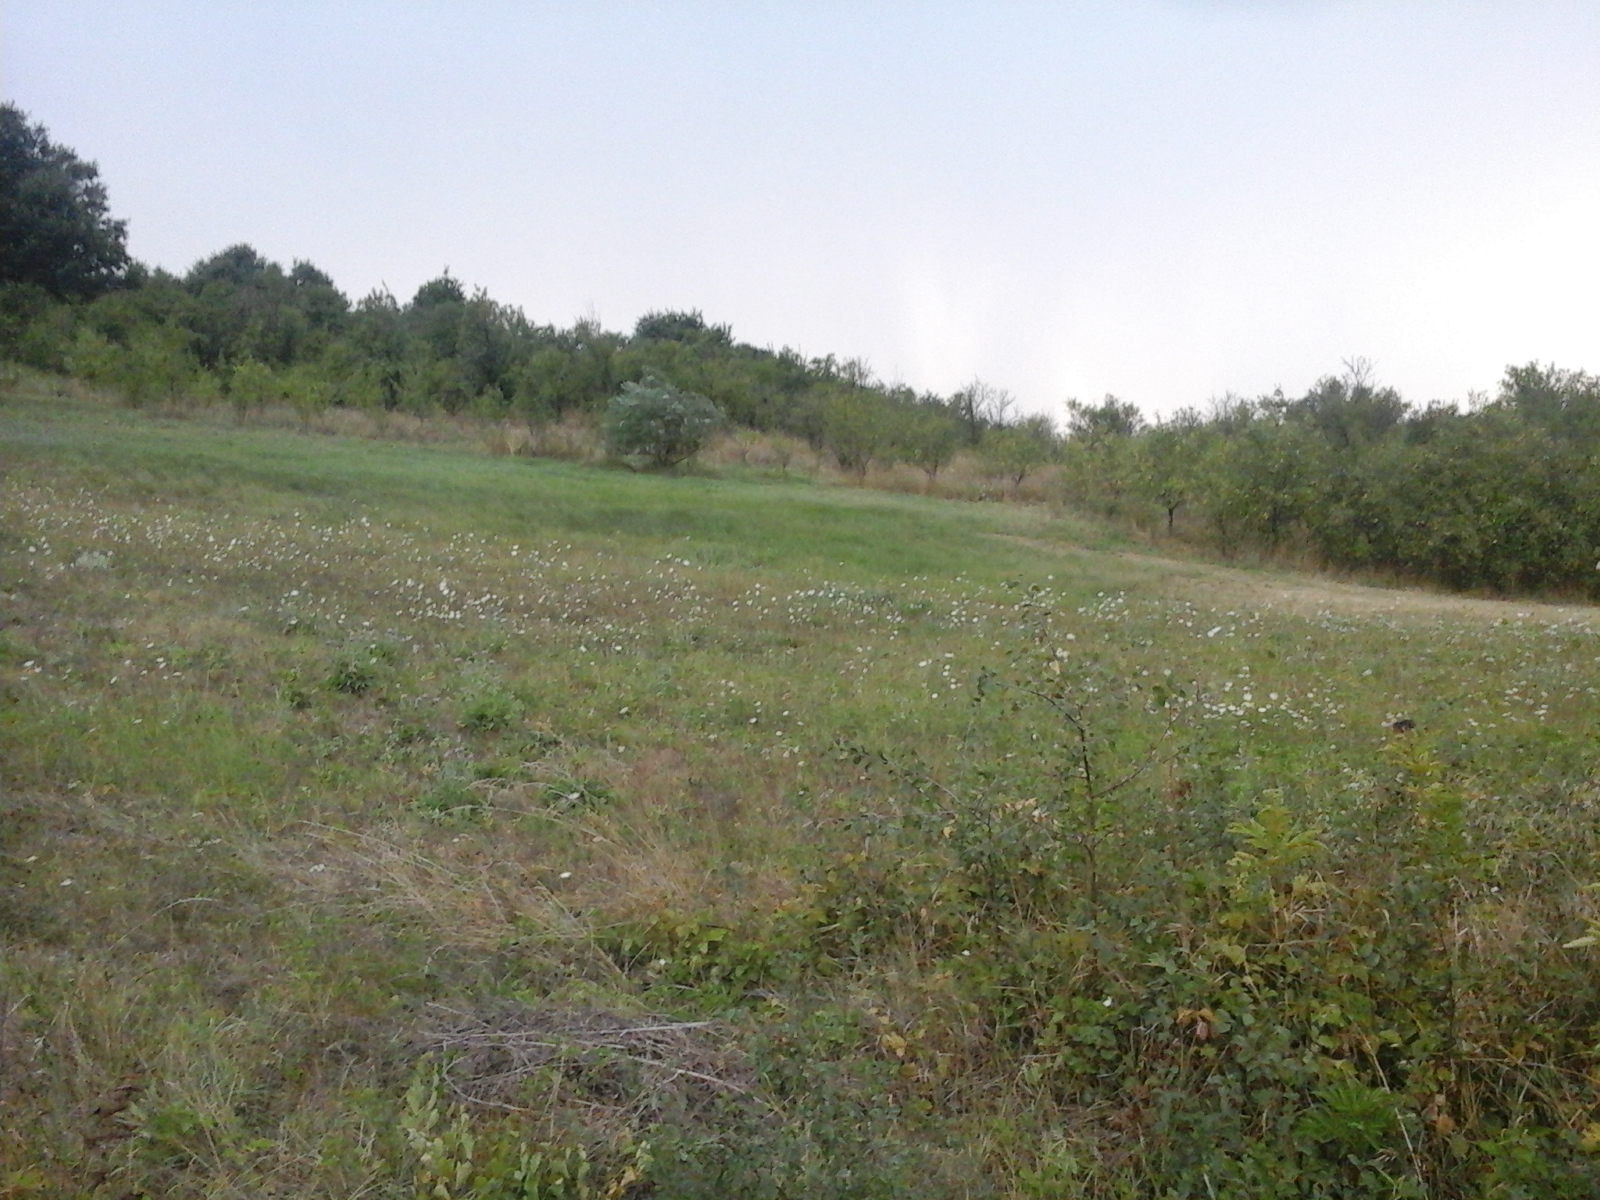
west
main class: Grassland
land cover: Grassland without tree/shrub cover
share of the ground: > 75 %
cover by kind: herbaceous plants 100 %
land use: Agriculture (excluding fallow land and kitchen gardens)
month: August
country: RO
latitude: 44.3327
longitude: 23.2793
